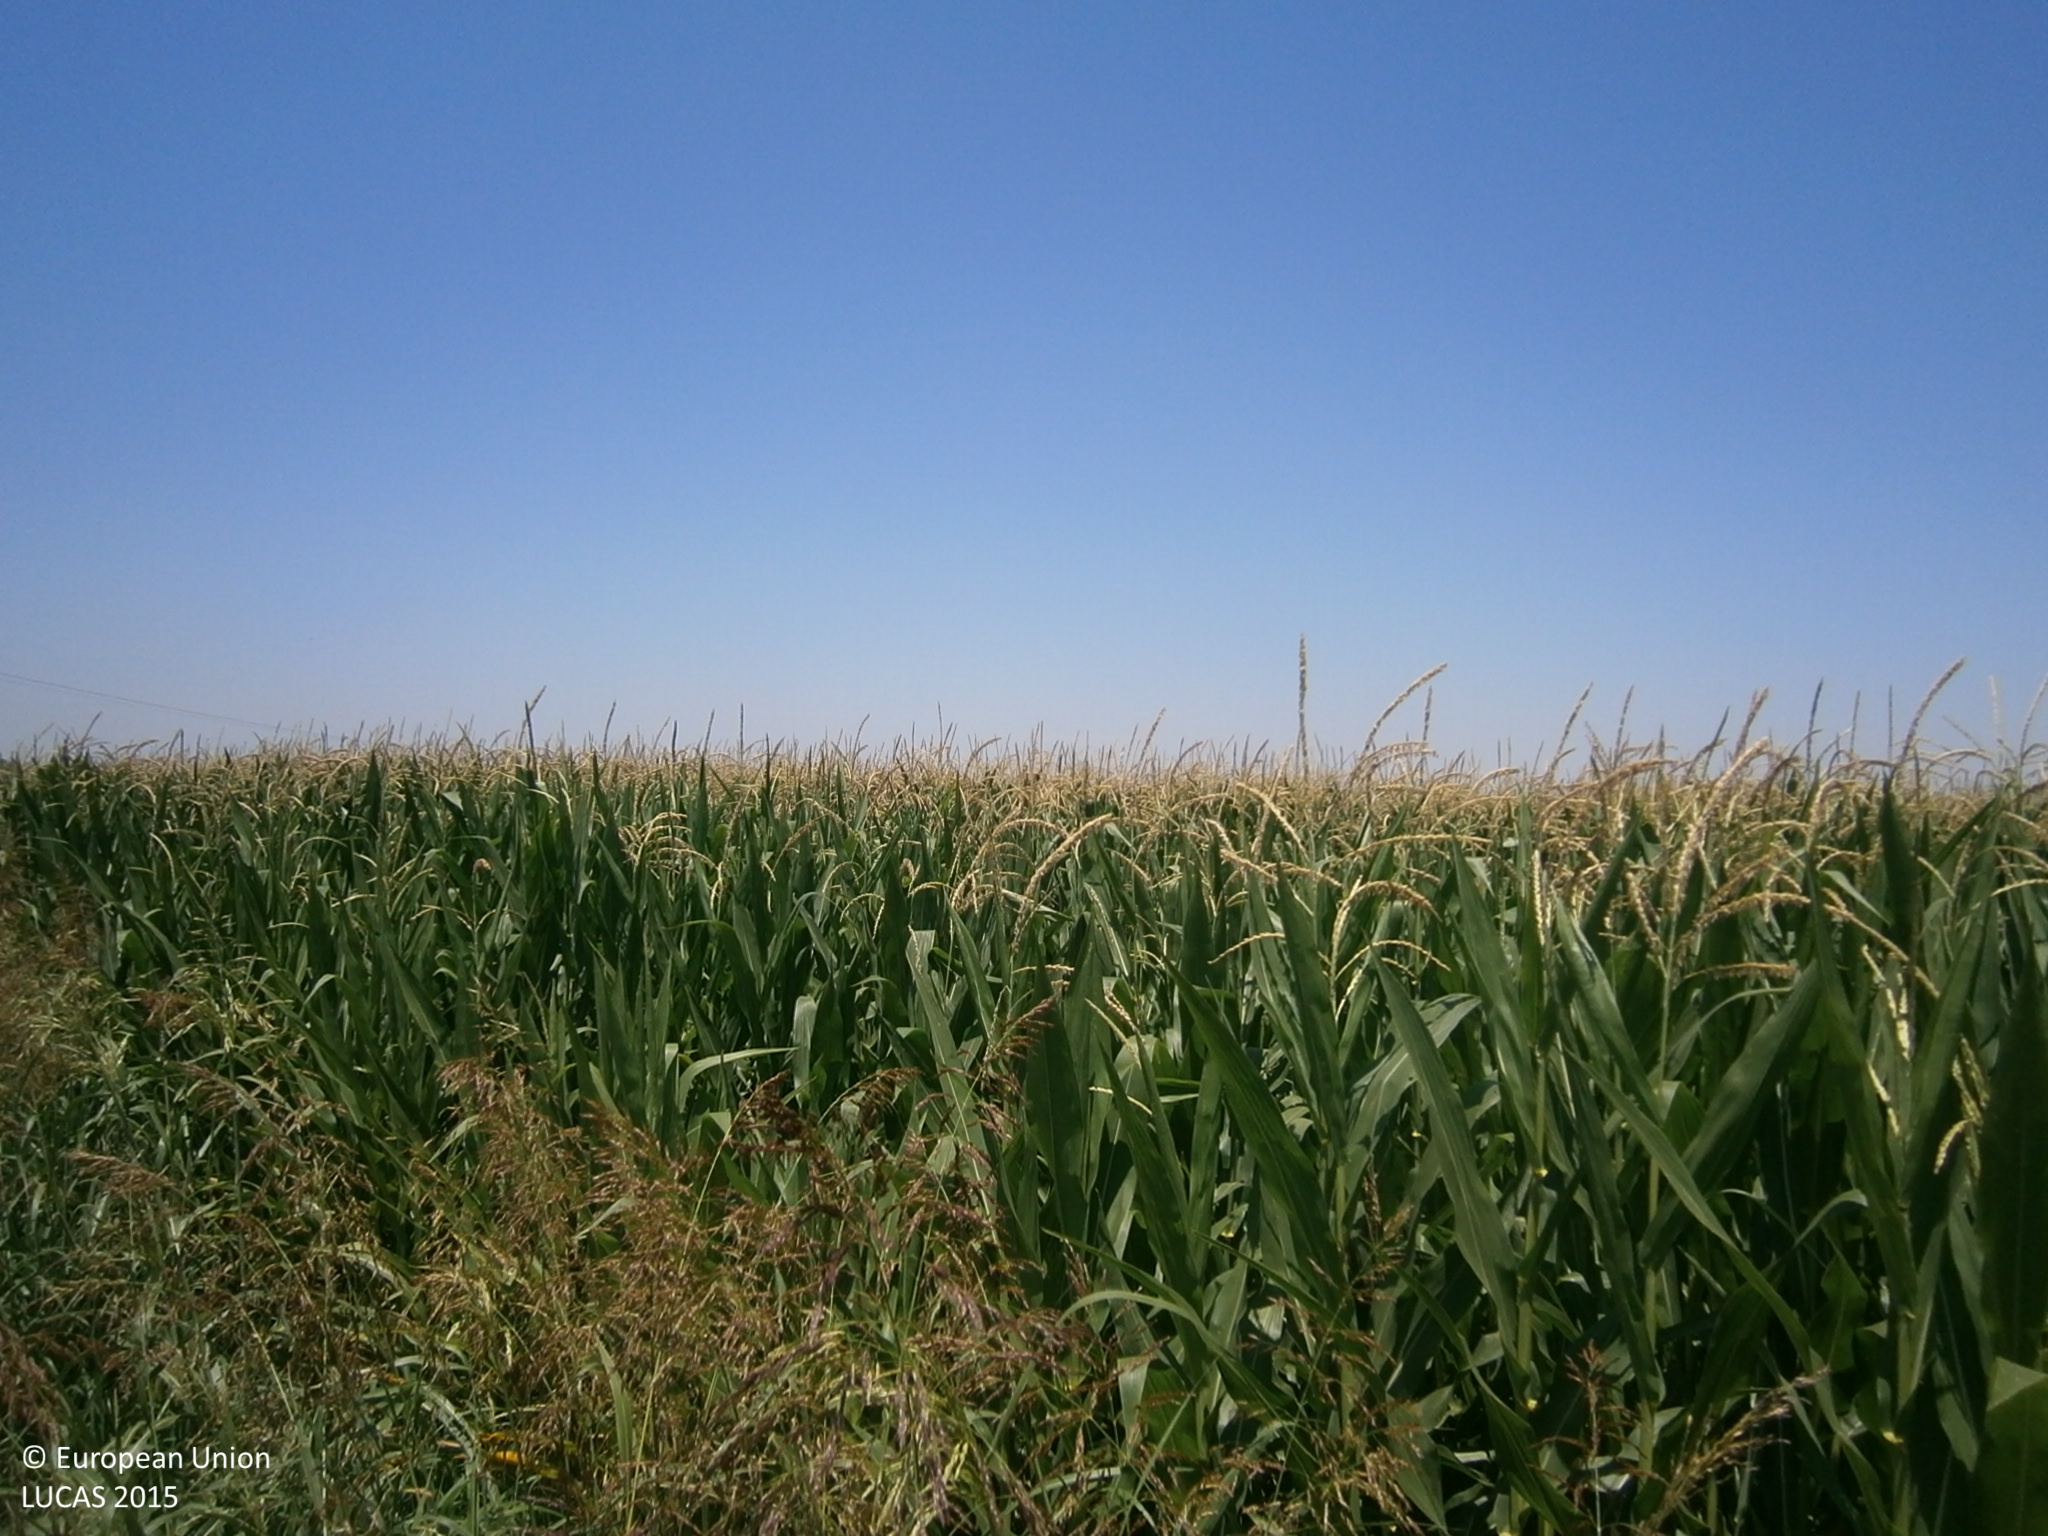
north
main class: Cropland
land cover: Maize
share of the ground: > 75 %
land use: Agriculture (excluding fallow land and kitchen gardens)
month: June
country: ES
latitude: 38.8802
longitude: -6.6980
